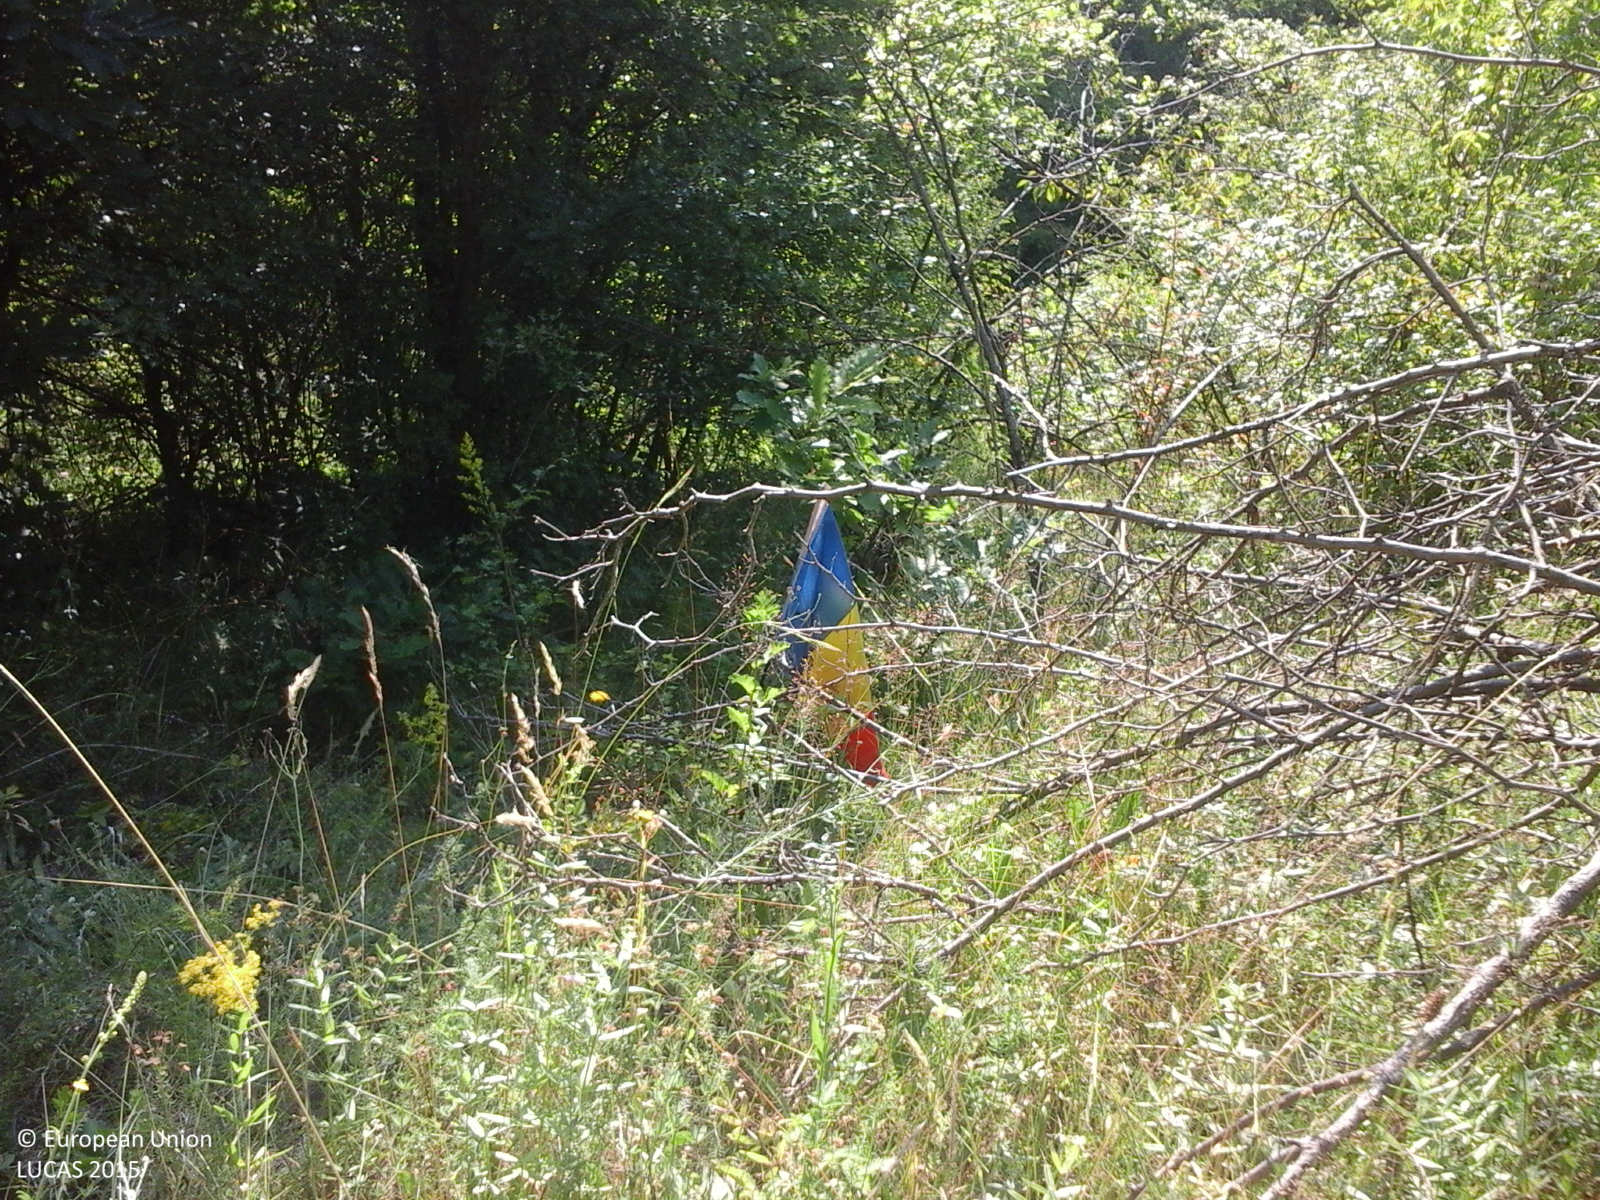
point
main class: Woodland
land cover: Broadleaved woodland
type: acidophilous oak and oak-birch forest
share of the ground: > 75 %
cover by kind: broadleaved forest trees 100 %
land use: Forestry
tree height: > 5 m
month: July
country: RO
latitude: 44.7975
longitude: 24.5748
